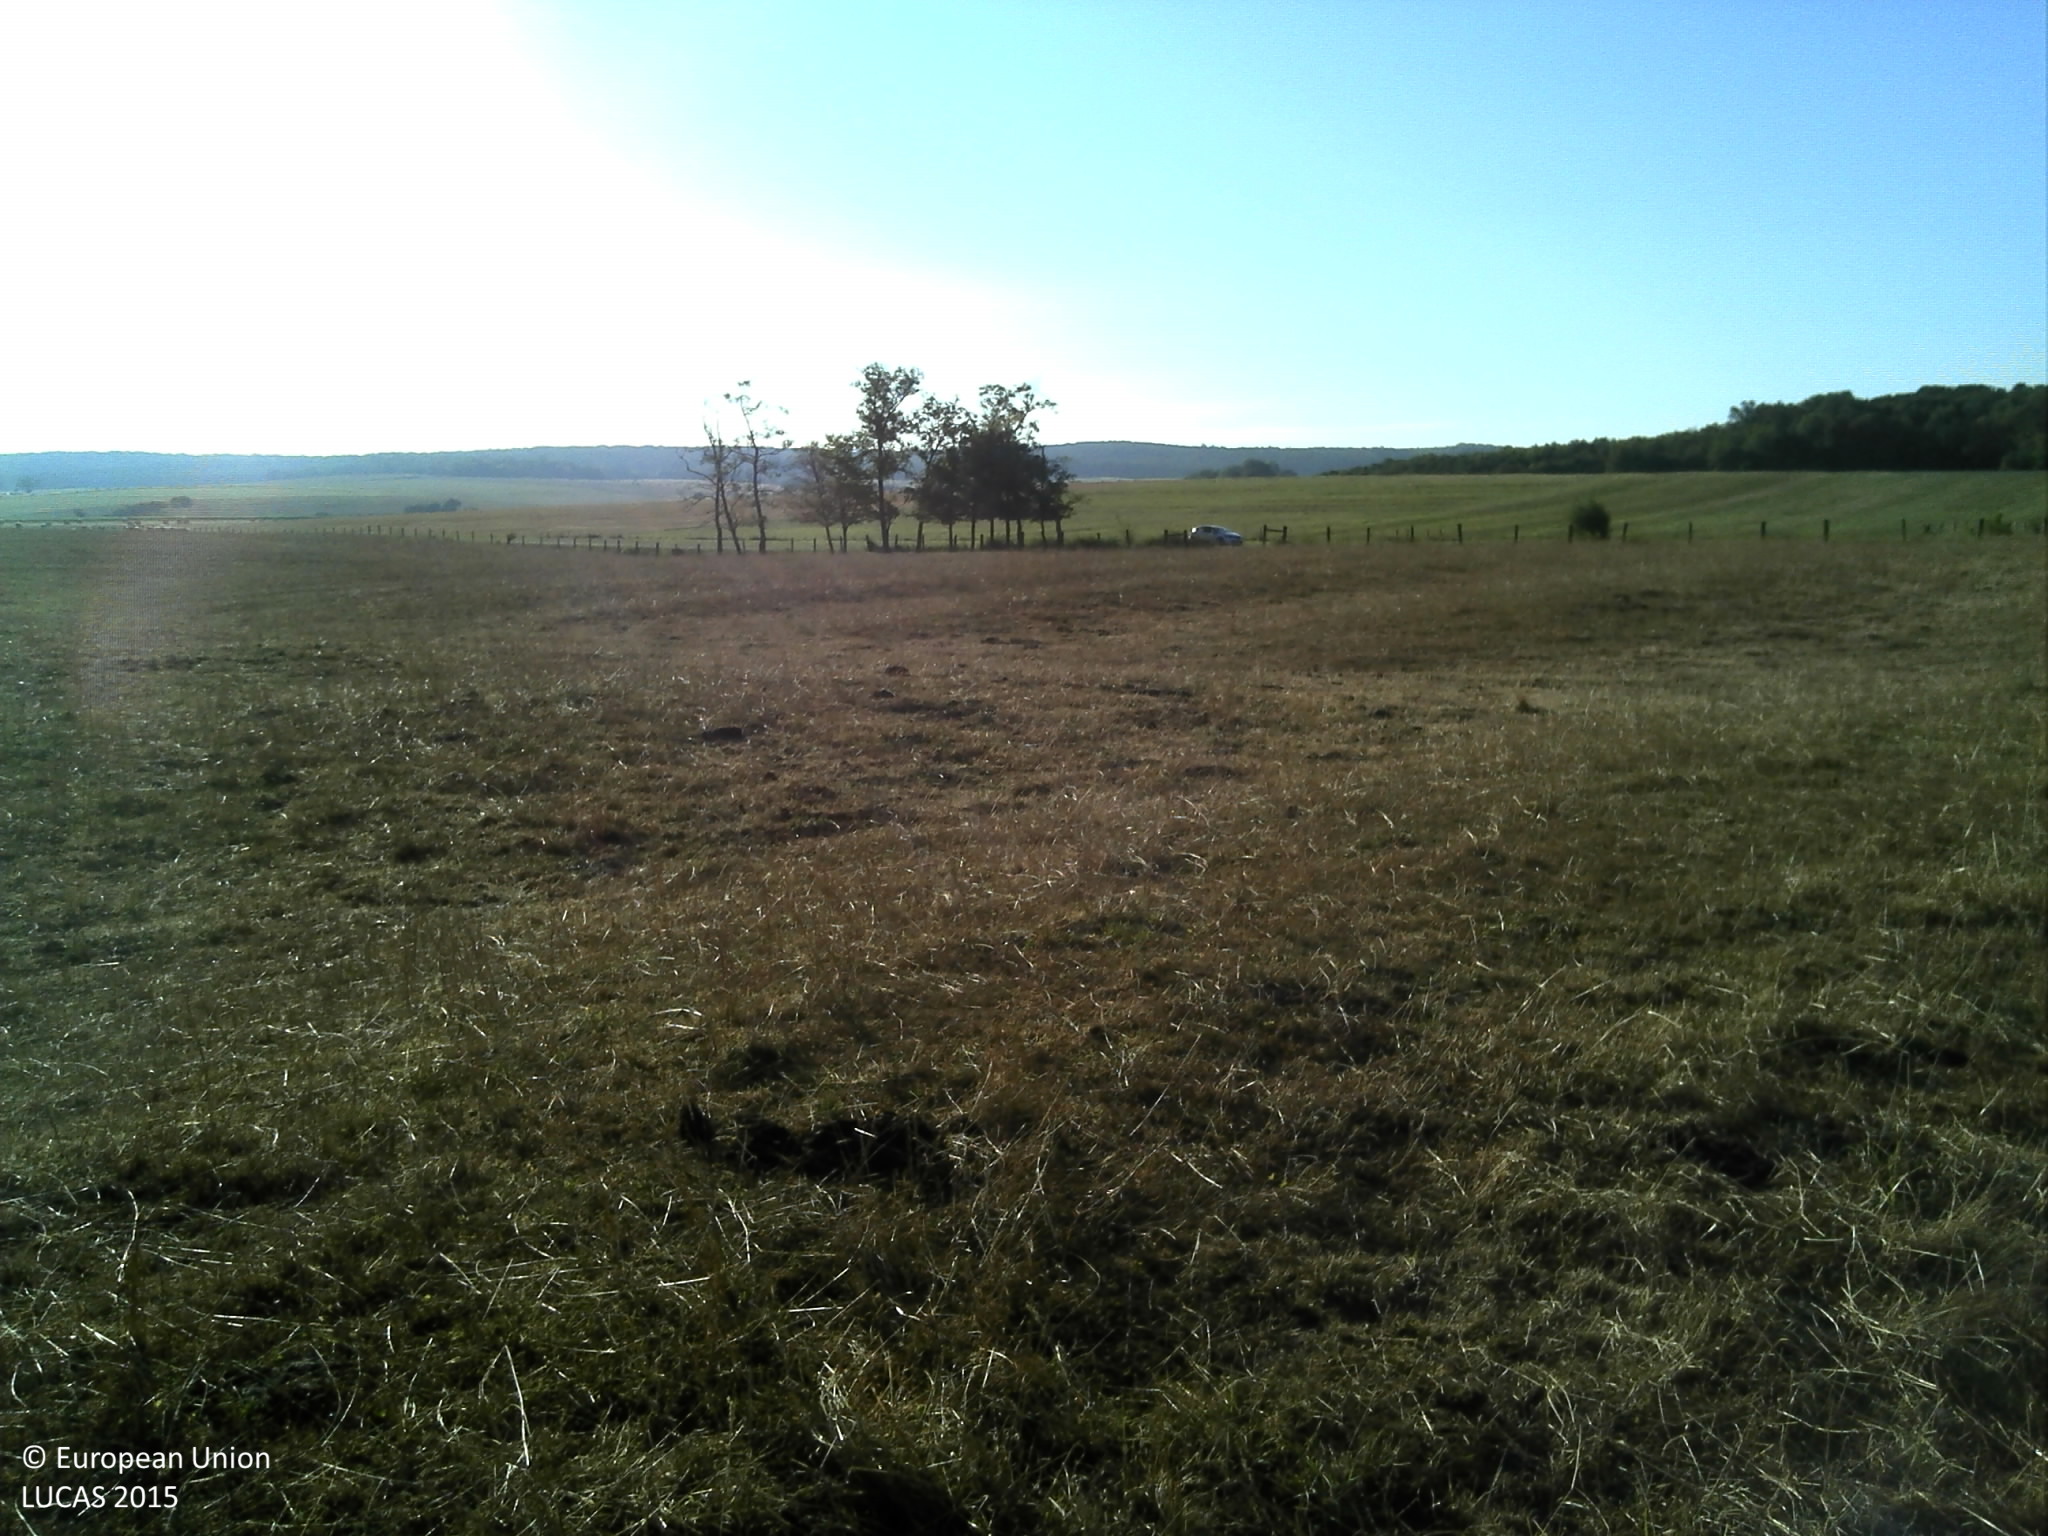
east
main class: Grassland
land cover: Grassland without tree/shrub cover
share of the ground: > 75 %
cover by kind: herbaceous plants 100 %
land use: Agriculture (excluding fallow land and kitchen gardens)
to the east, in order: Grassland without tree/shrub cover; Grassland with sparse tree/shrub cover; Fences; Ditches and canals; Paved roads, cycling and walking lanes; Grassland without tree/shrub cover
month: July
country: FR
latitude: 48.2279
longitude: 6.1369
